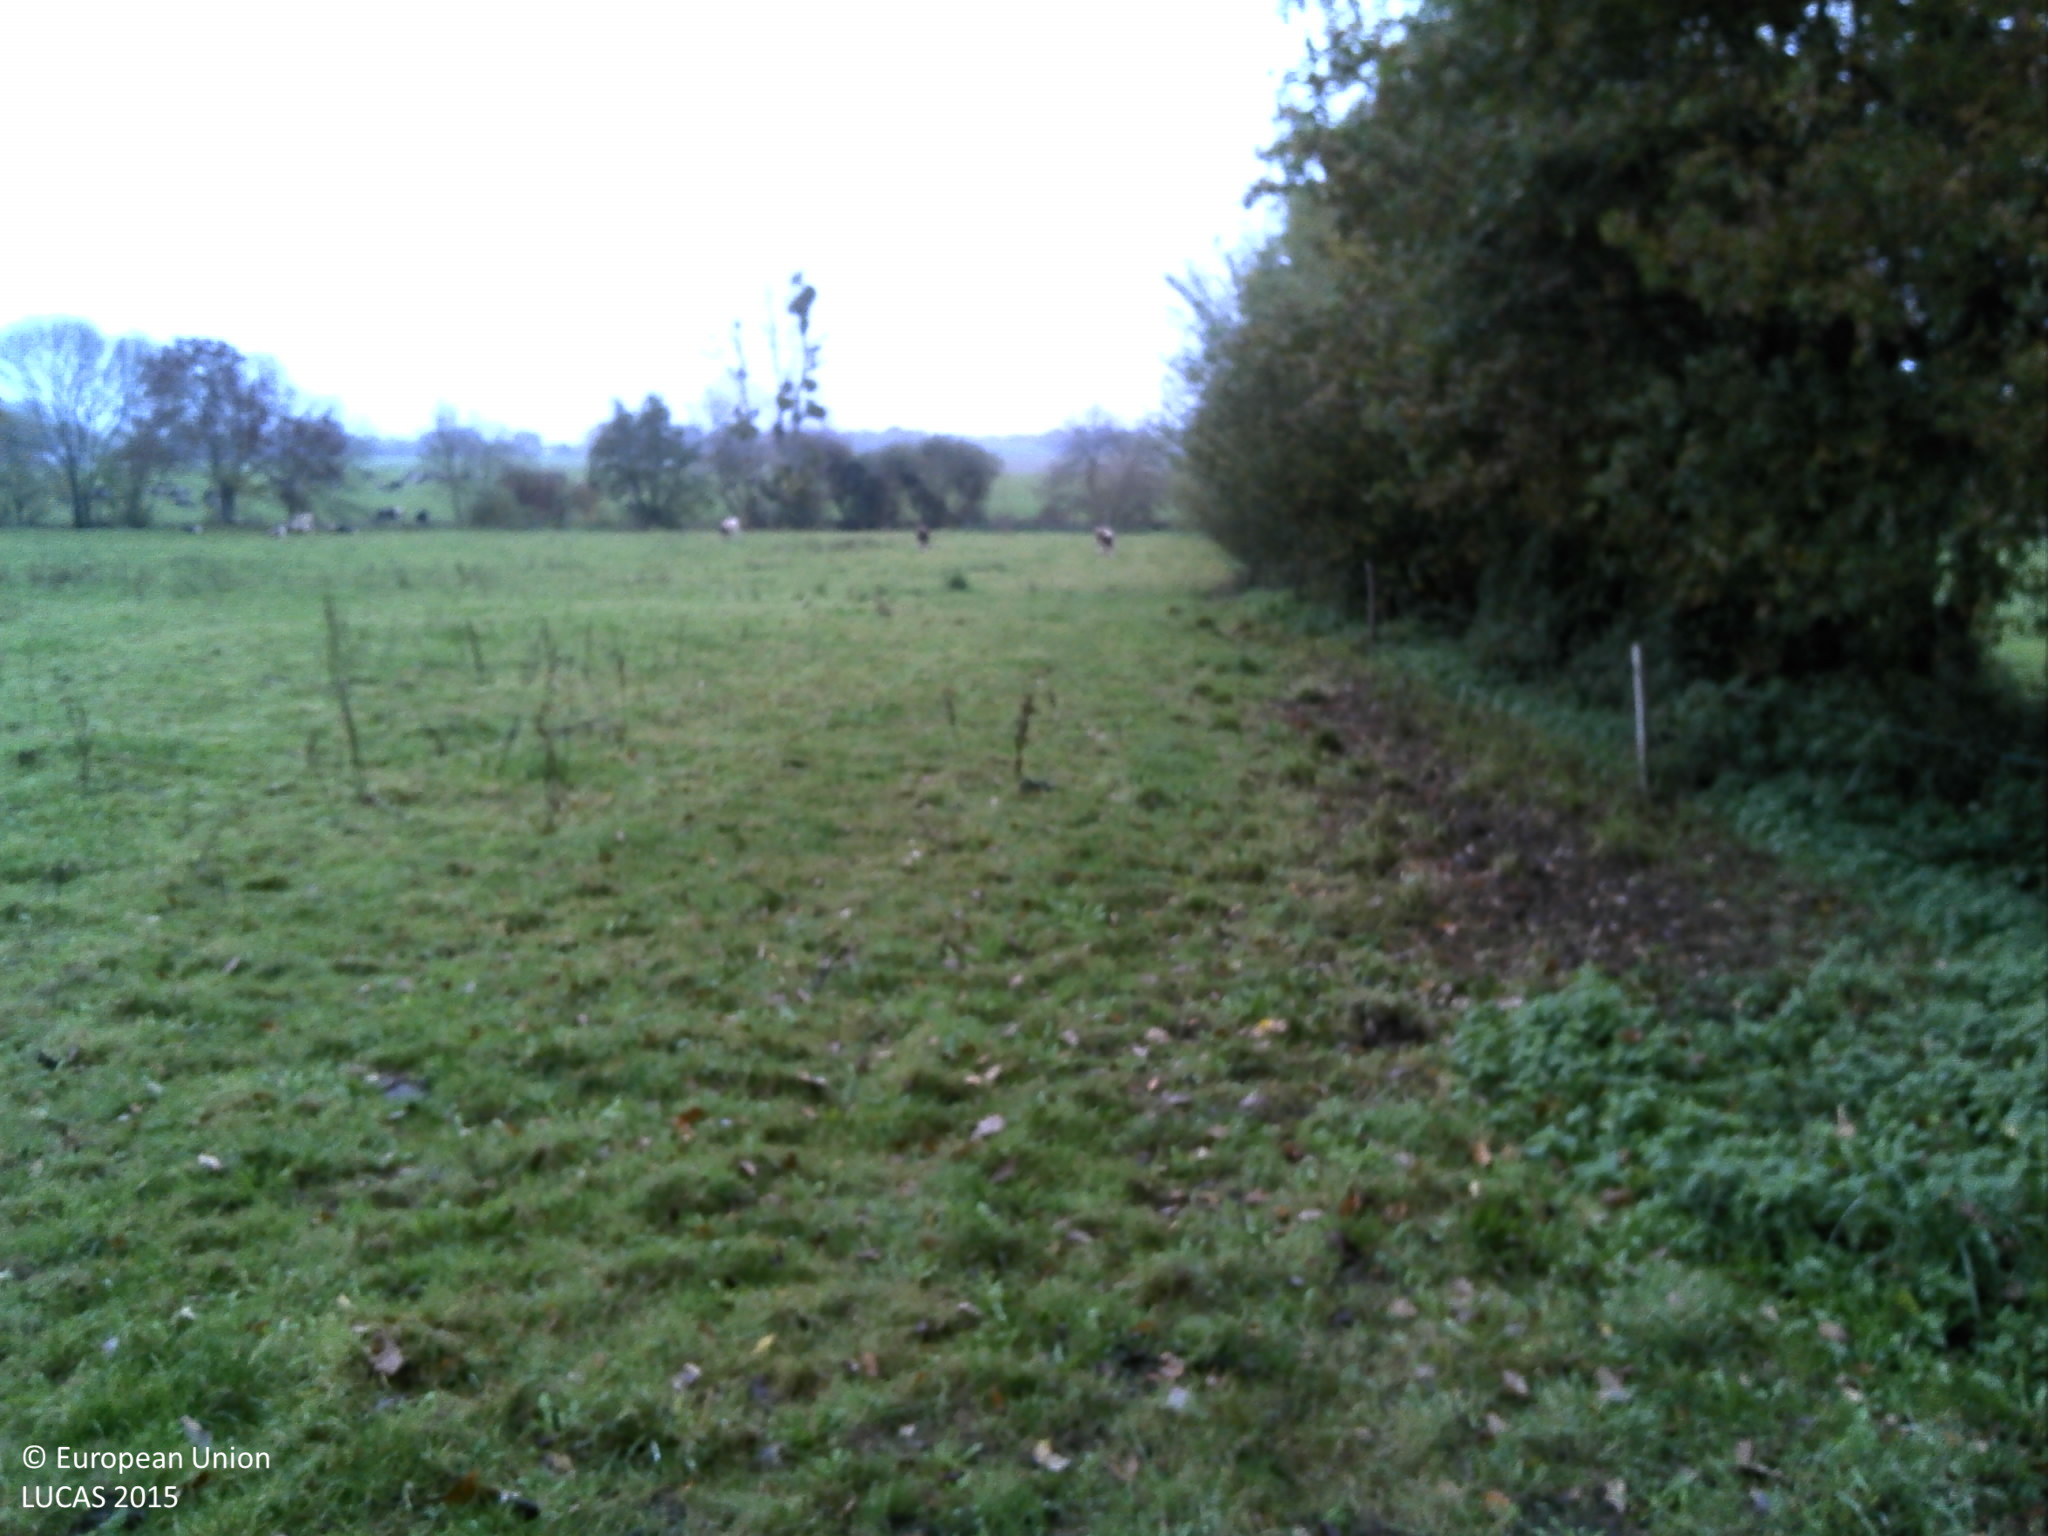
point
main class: Cropland
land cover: Temporary grasslands
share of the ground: > 75 %
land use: Agriculture (excluding fallow land and kitchen gardens)
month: November
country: FR
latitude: 47.6168
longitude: -1.5256
